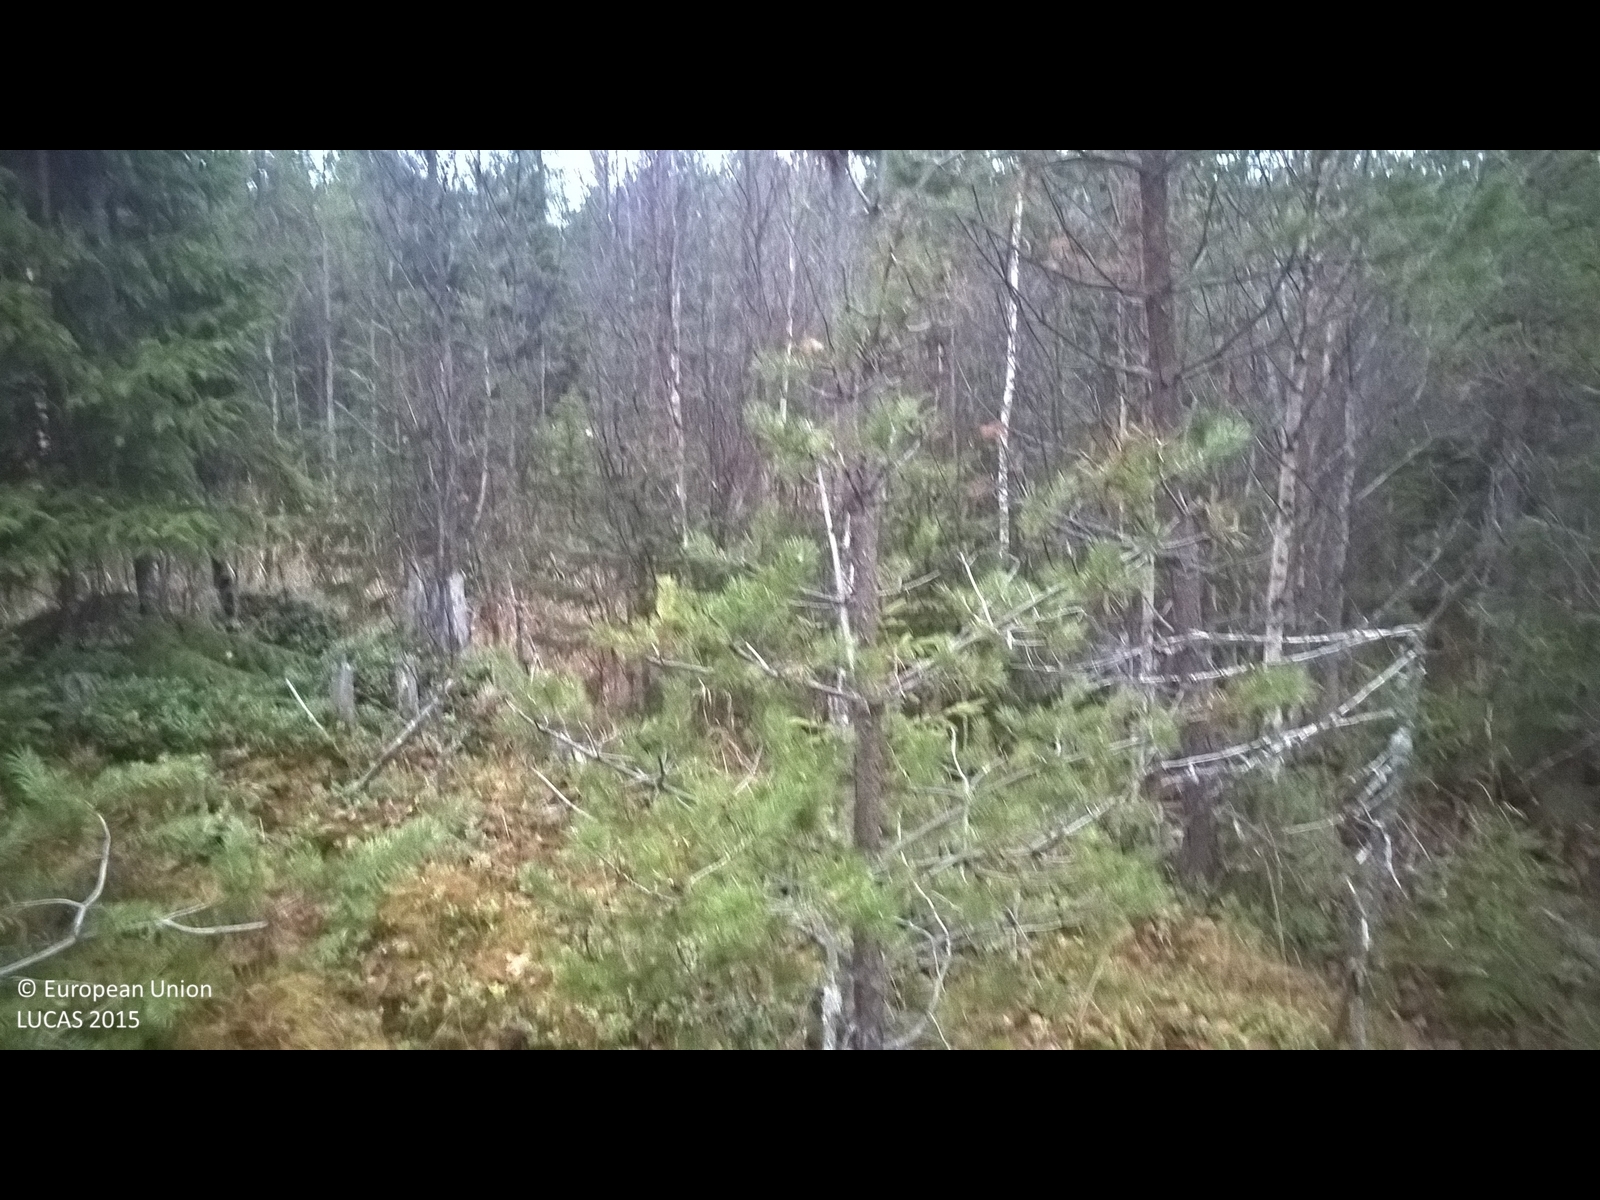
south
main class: Woodland
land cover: Pine dominated mixed woodland
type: exotic forest
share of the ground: 50 - 75 %
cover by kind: coniferous forest trees 40 %, broadleaved forest trees 35 %, lichens and mosses 15 %, shrubs 5 %, herbaceous plants 5 %
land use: Forestry
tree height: > 5 m
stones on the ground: < 10 %
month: October
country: SE
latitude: 62.8089
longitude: 16.2350
